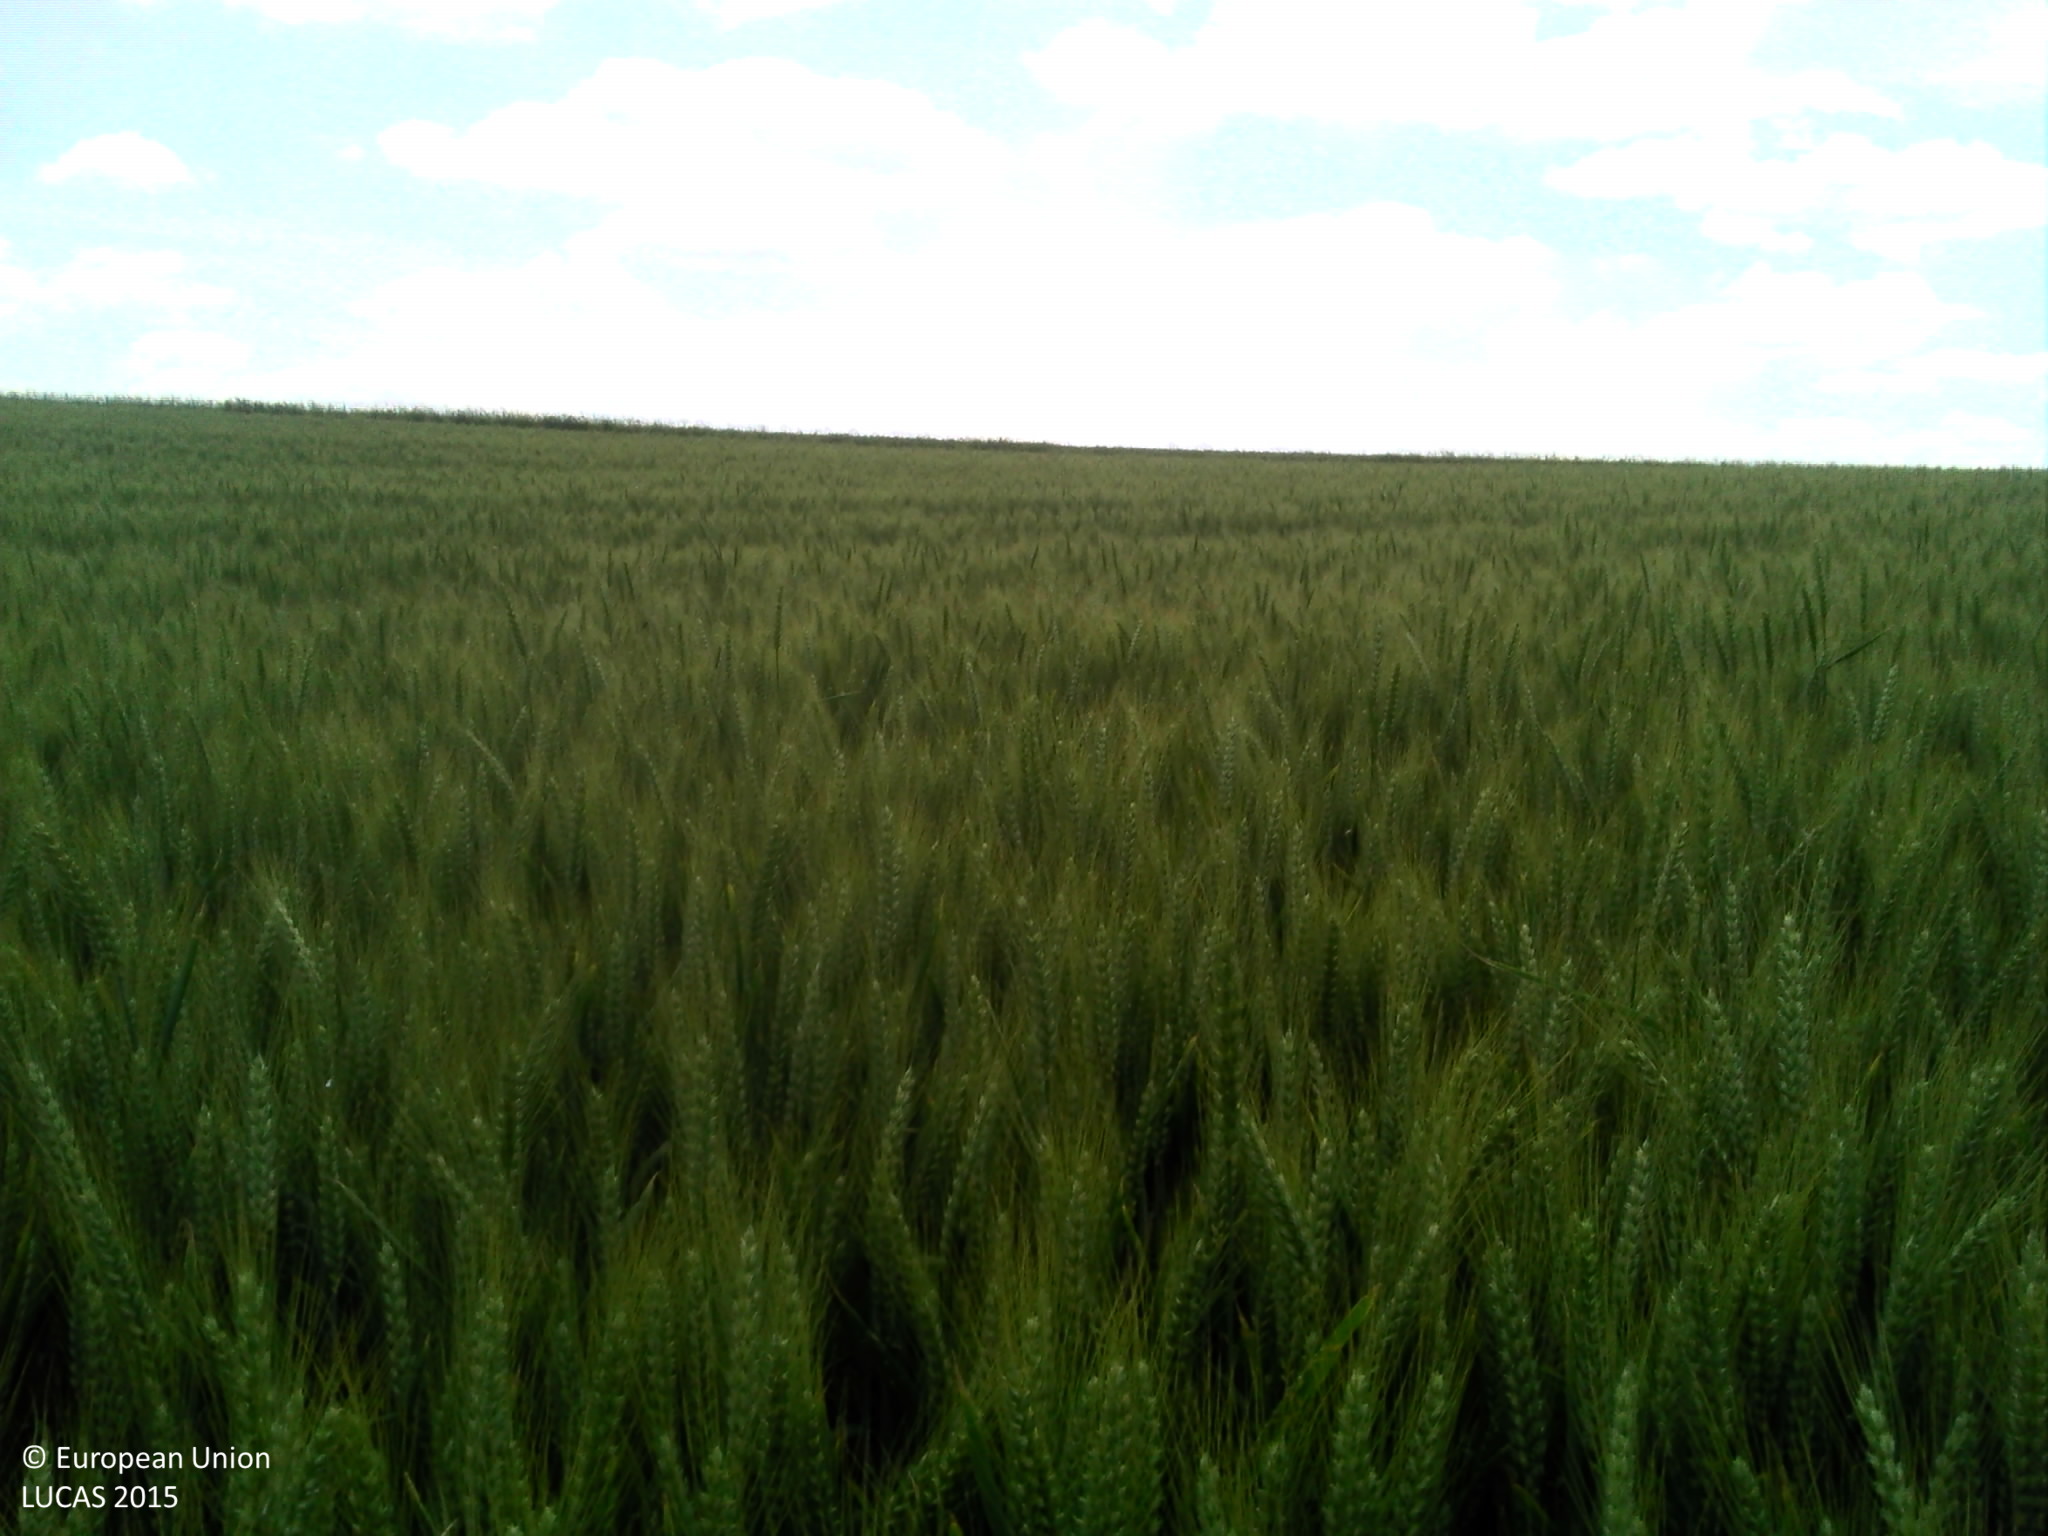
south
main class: Cropland
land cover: Durum wheat
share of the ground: > 75 %
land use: Agriculture (excluding fallow land and kitchen gardens)
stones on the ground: < 10 %
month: June
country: FR
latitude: 49.6675
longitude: 2.5199
